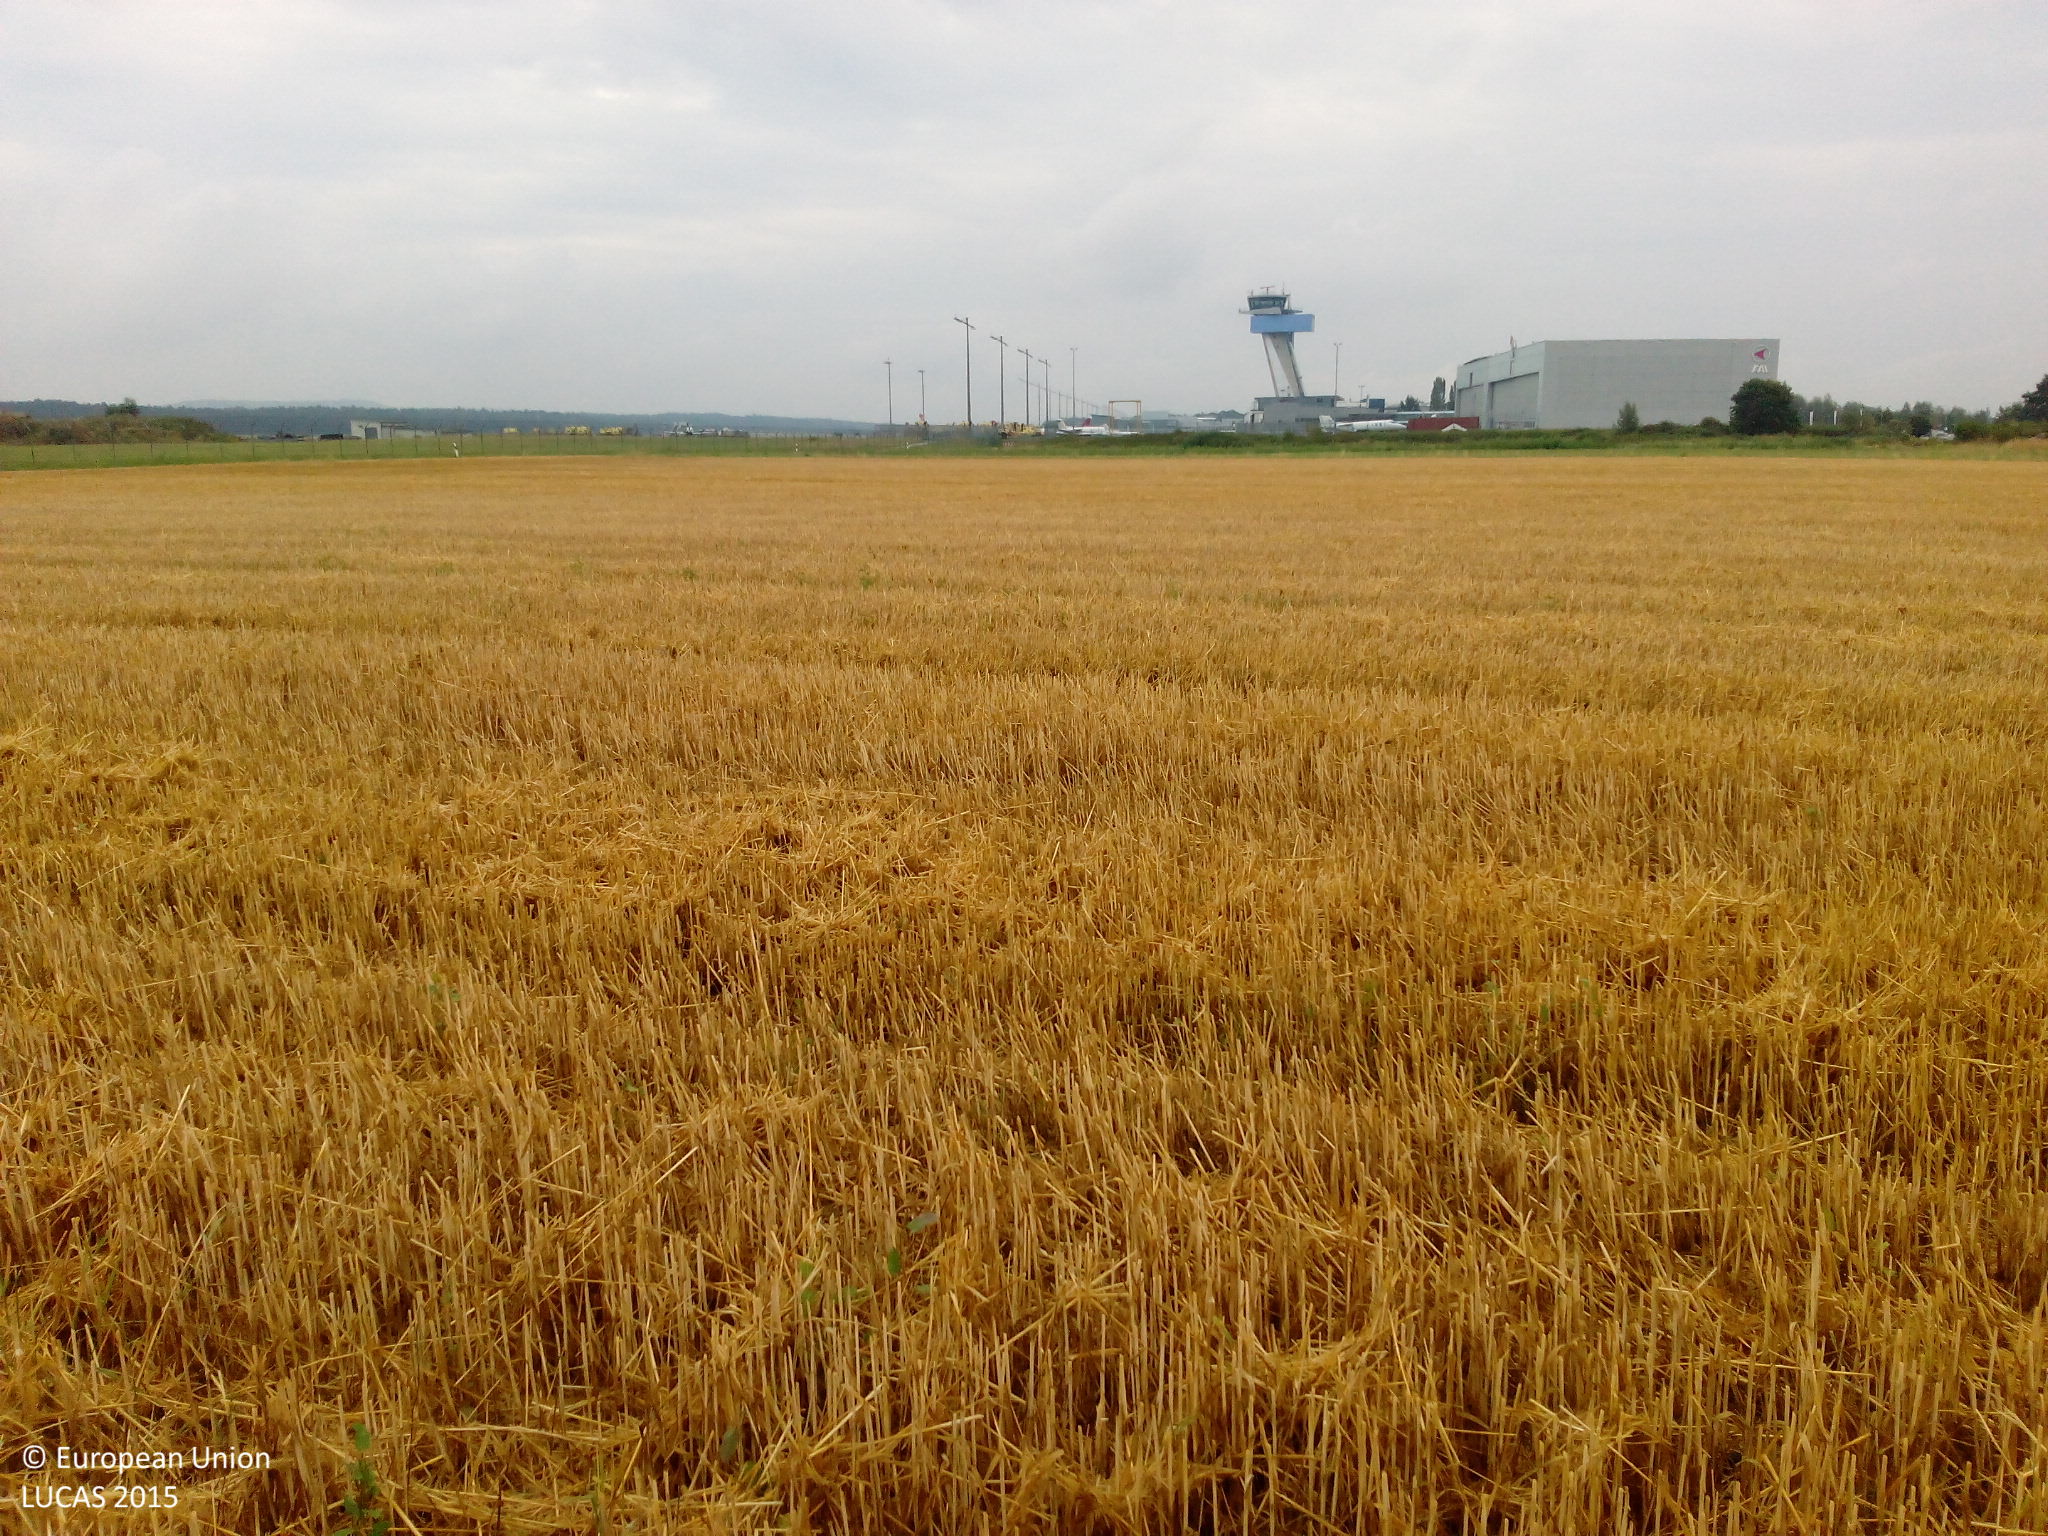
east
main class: Cropland
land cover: Rye
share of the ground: 25 - 50 %
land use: Agriculture (excluding fallow land and kitchen gardens)
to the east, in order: Rye; Grassland without tree/shrub cover; Spontaneously vegetated surfaces; Grassland without tree/shrub cover; Paved roads, cycling and walking lanes
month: July
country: DE
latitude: 49.4958
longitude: 11.0627
